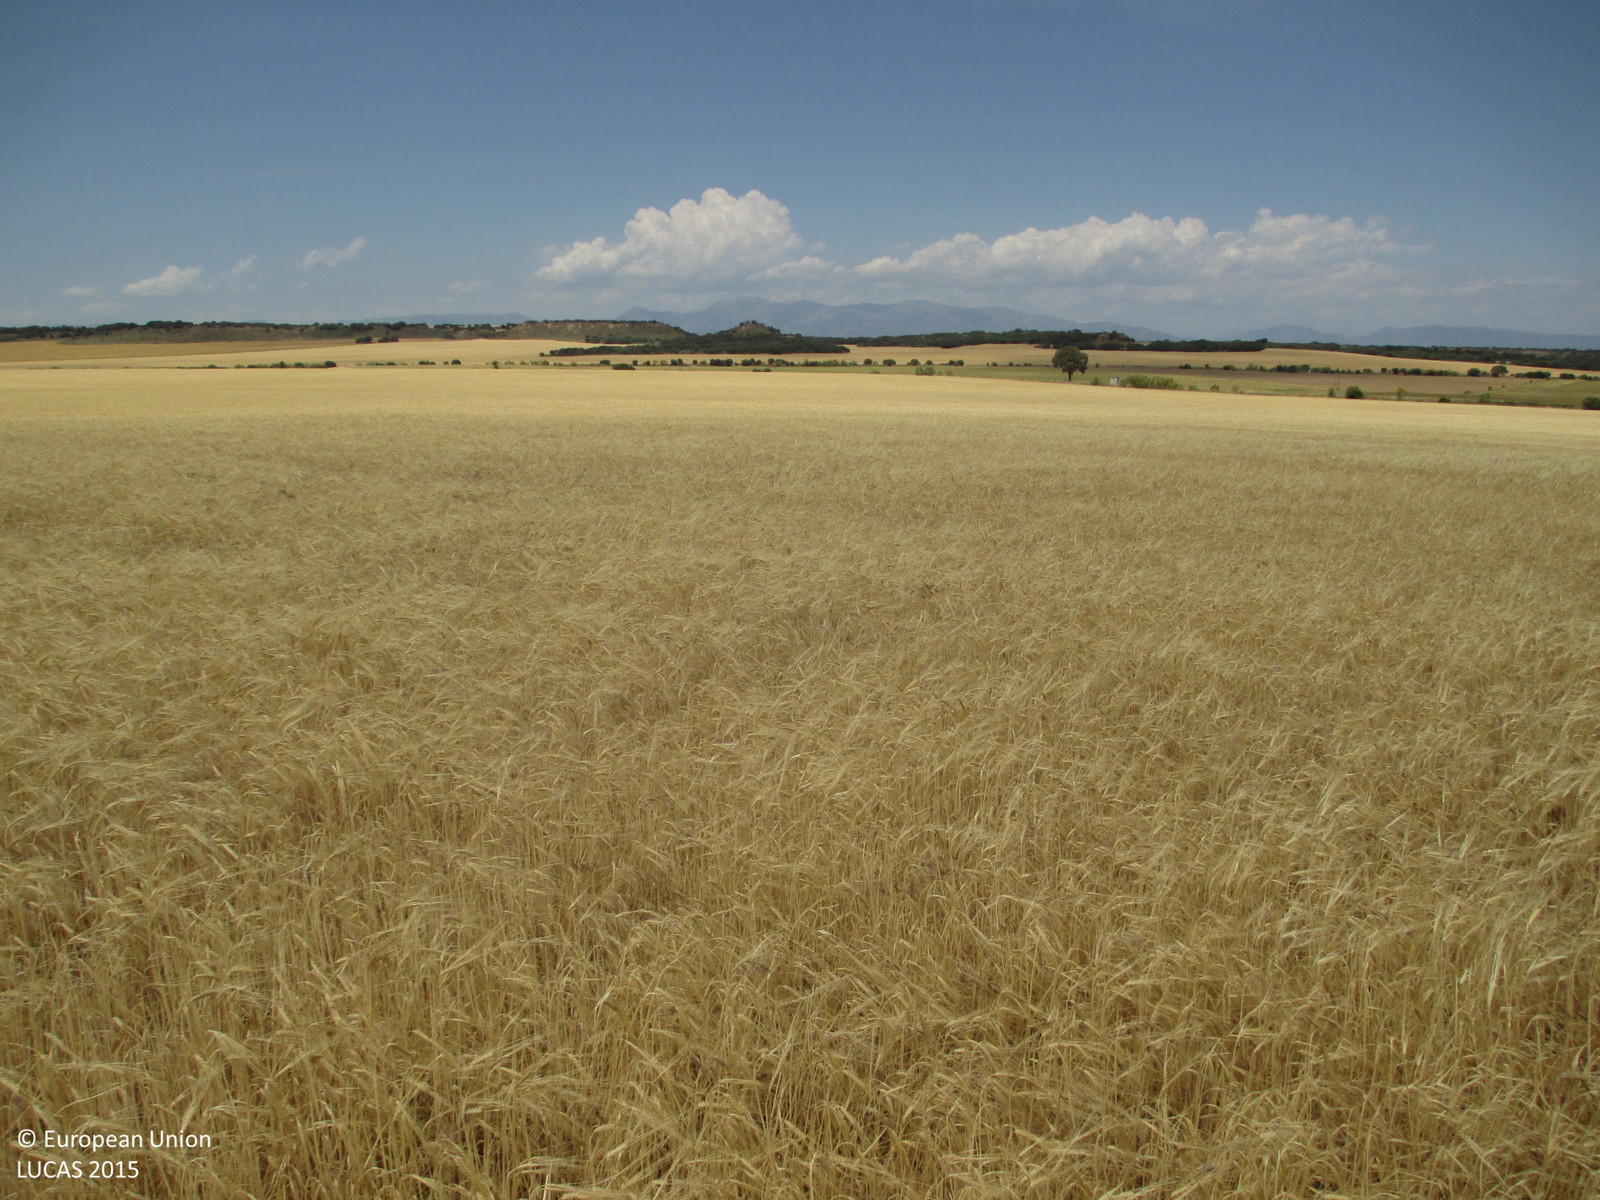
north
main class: Cropland
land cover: Barley
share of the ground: > 75 %
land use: Agriculture (excluding fallow land and kitchen gardens)
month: May
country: ES
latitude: 41.9545
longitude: -0.2139
